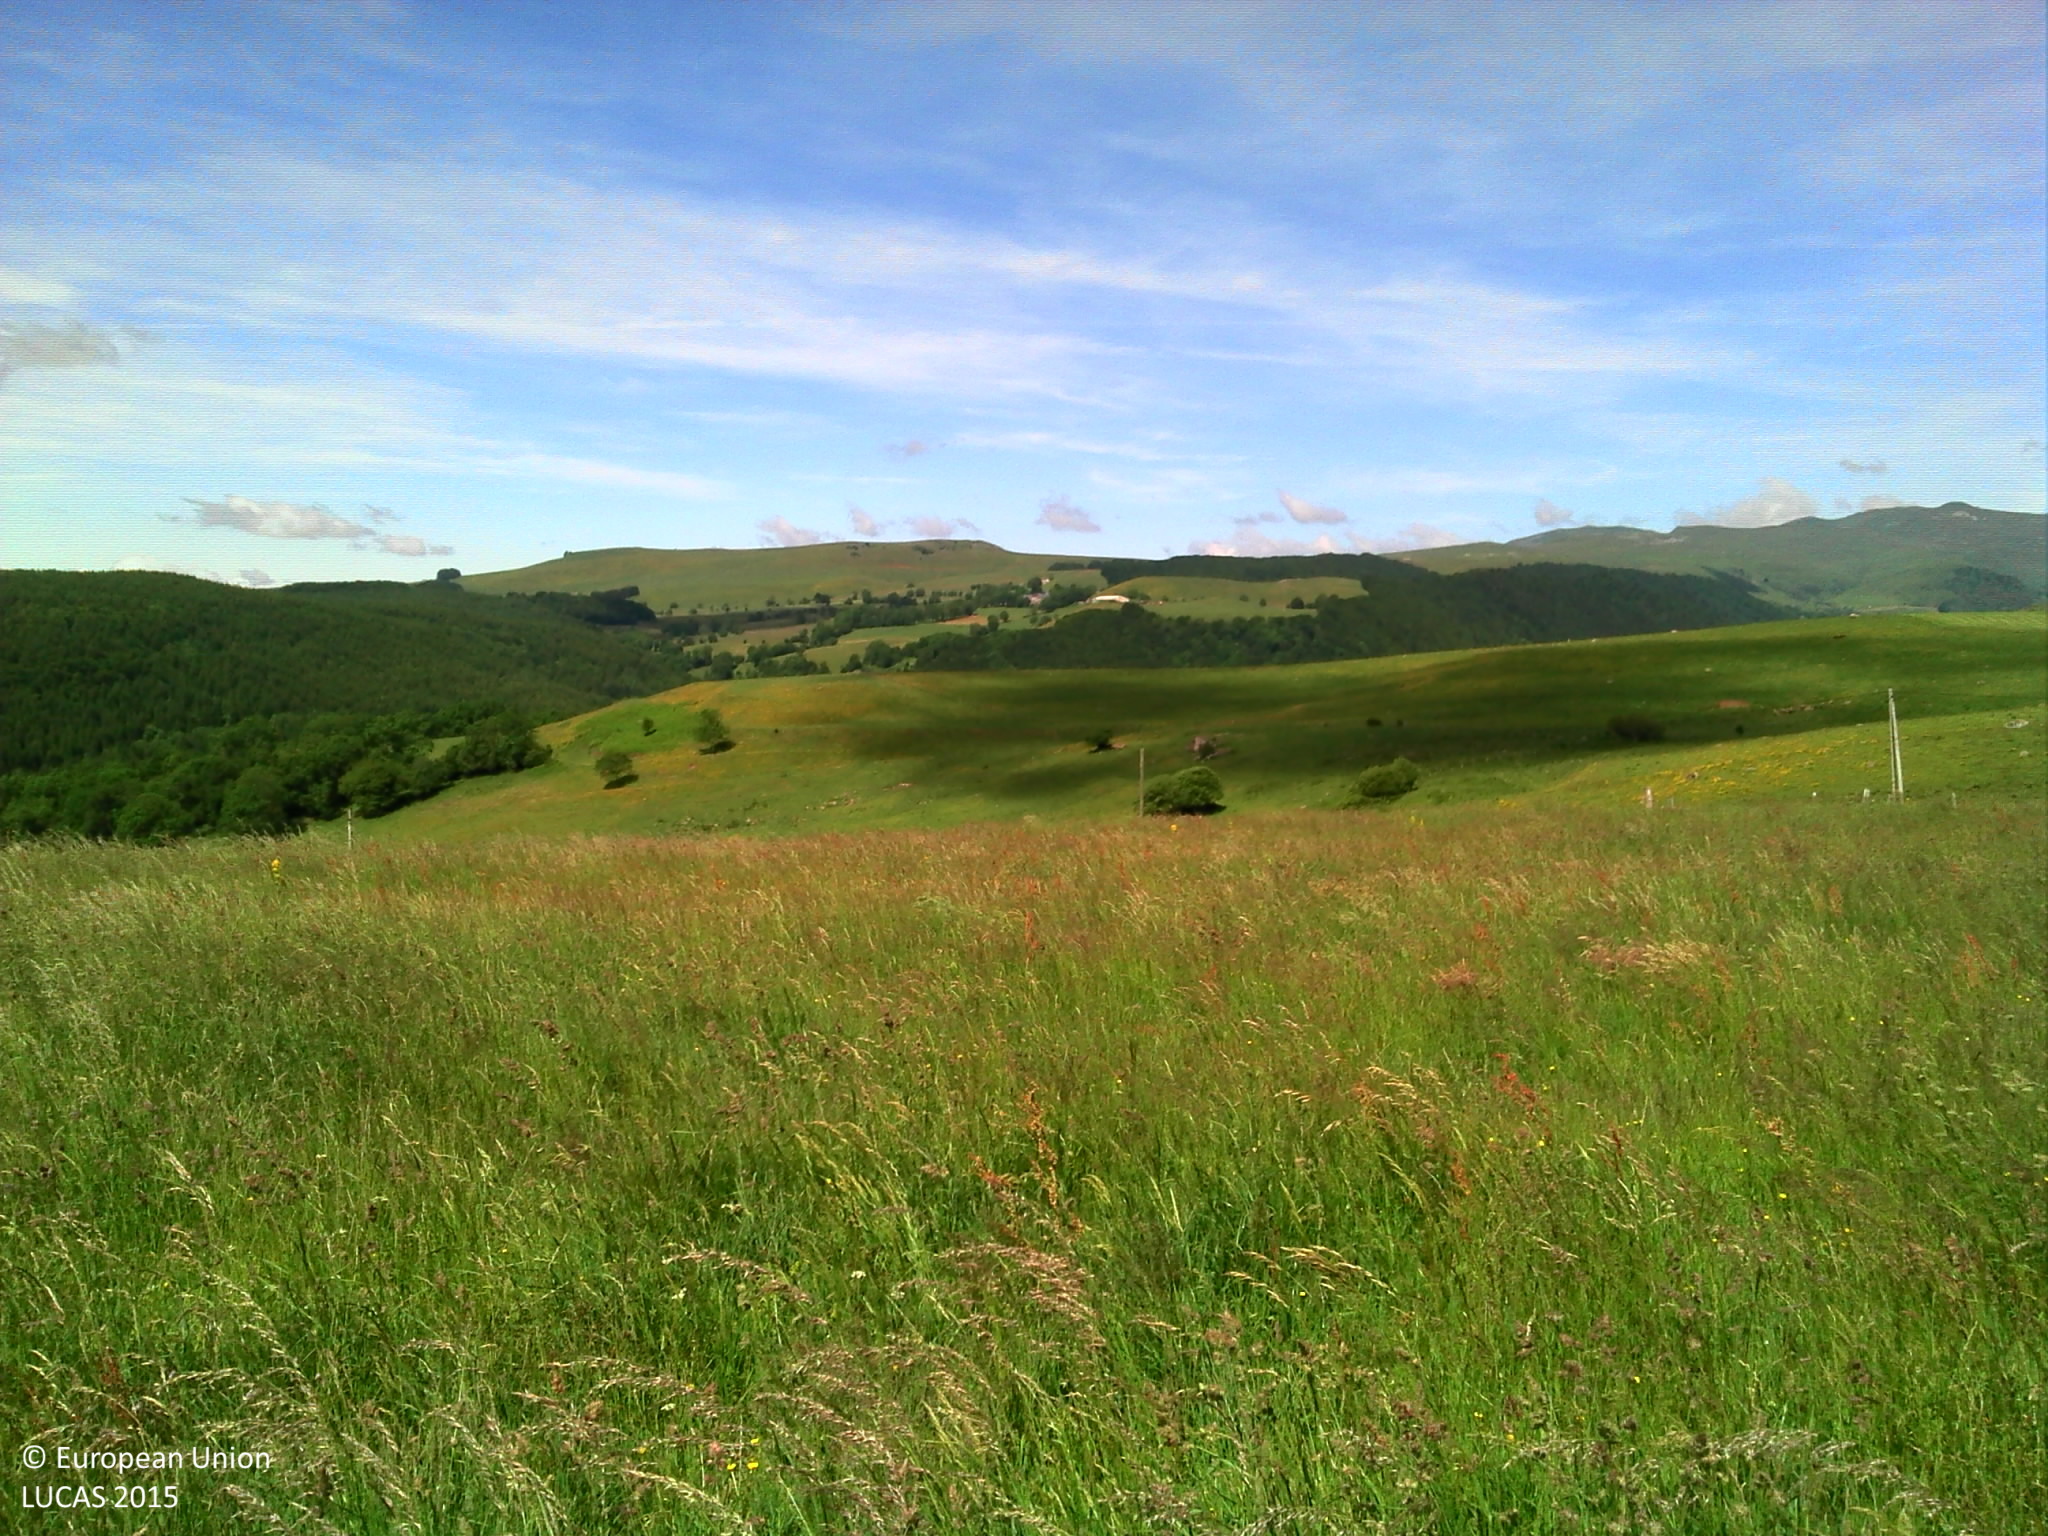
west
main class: Grassland
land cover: Grassland without tree/shrub cover
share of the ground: > 75 %
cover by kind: herbaceous plants 100 %
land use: Agriculture (excluding fallow land and kitchen gardens)
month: June
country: FR
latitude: 45.0109
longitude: 2.8836
